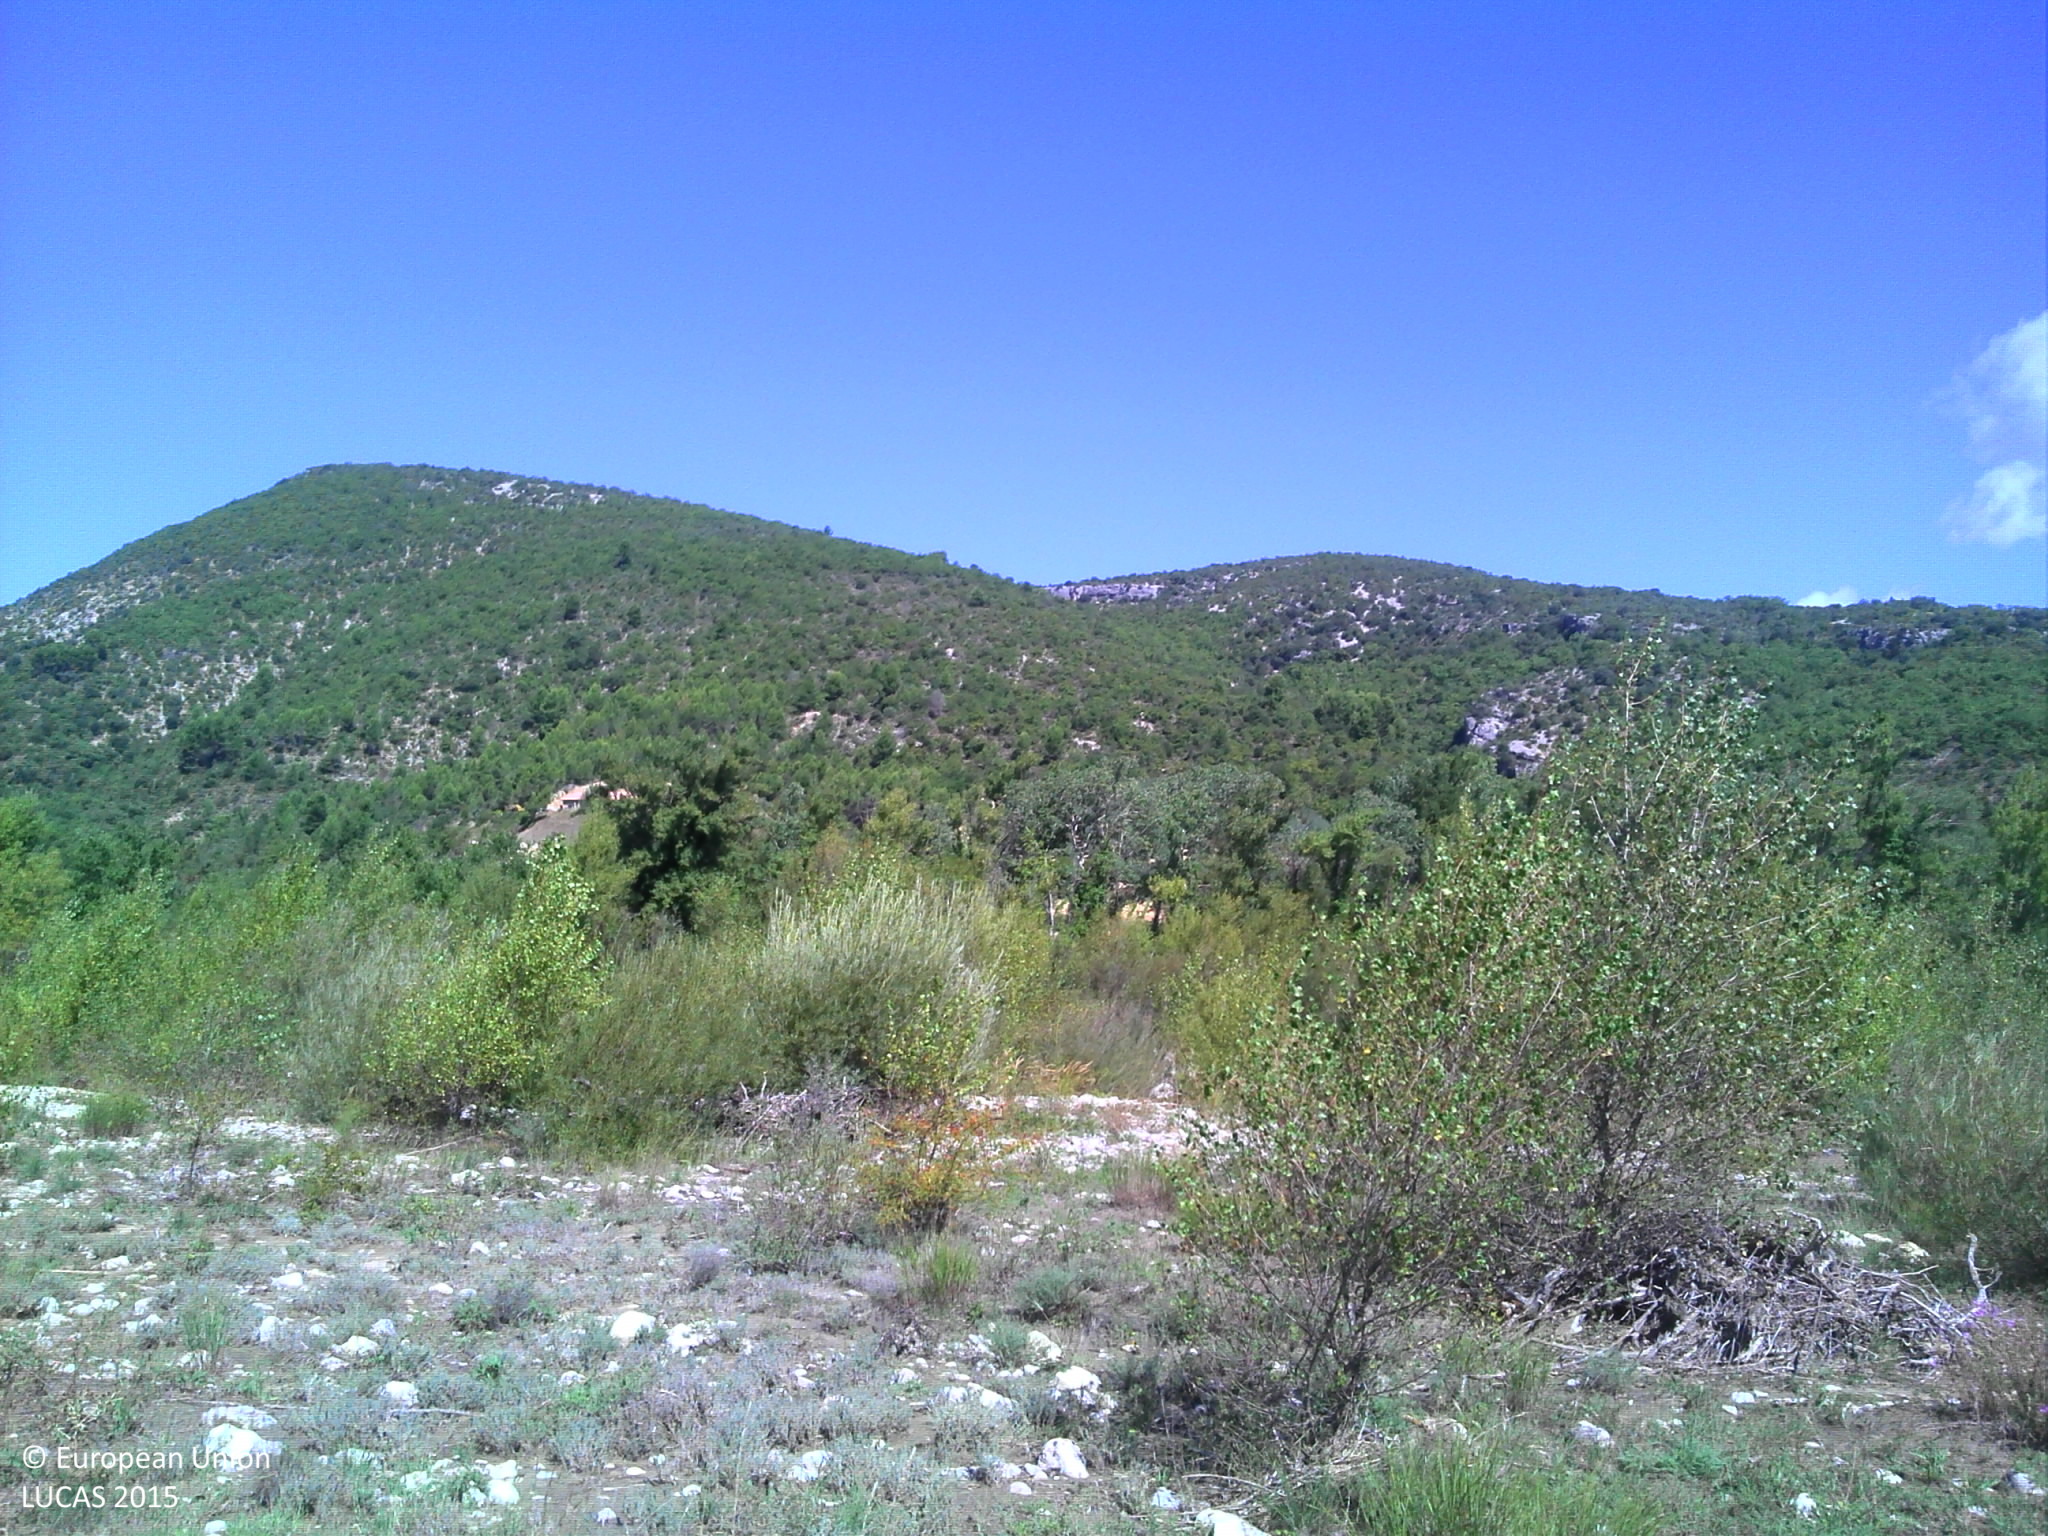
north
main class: Woodland
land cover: Broadleaved woodland
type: thermophilous deciduous forest
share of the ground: 25 - 50 %
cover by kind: broadleaved forest trees 50 %, unconsolidated bare surface 35 %, consolidated bare surface 10 %, coniferous forest trees 5 %
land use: Semi-natural and natural areas not in use
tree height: > 5 m
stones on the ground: < 10 %
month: September
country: FR
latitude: 44.3852
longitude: 5.2249
